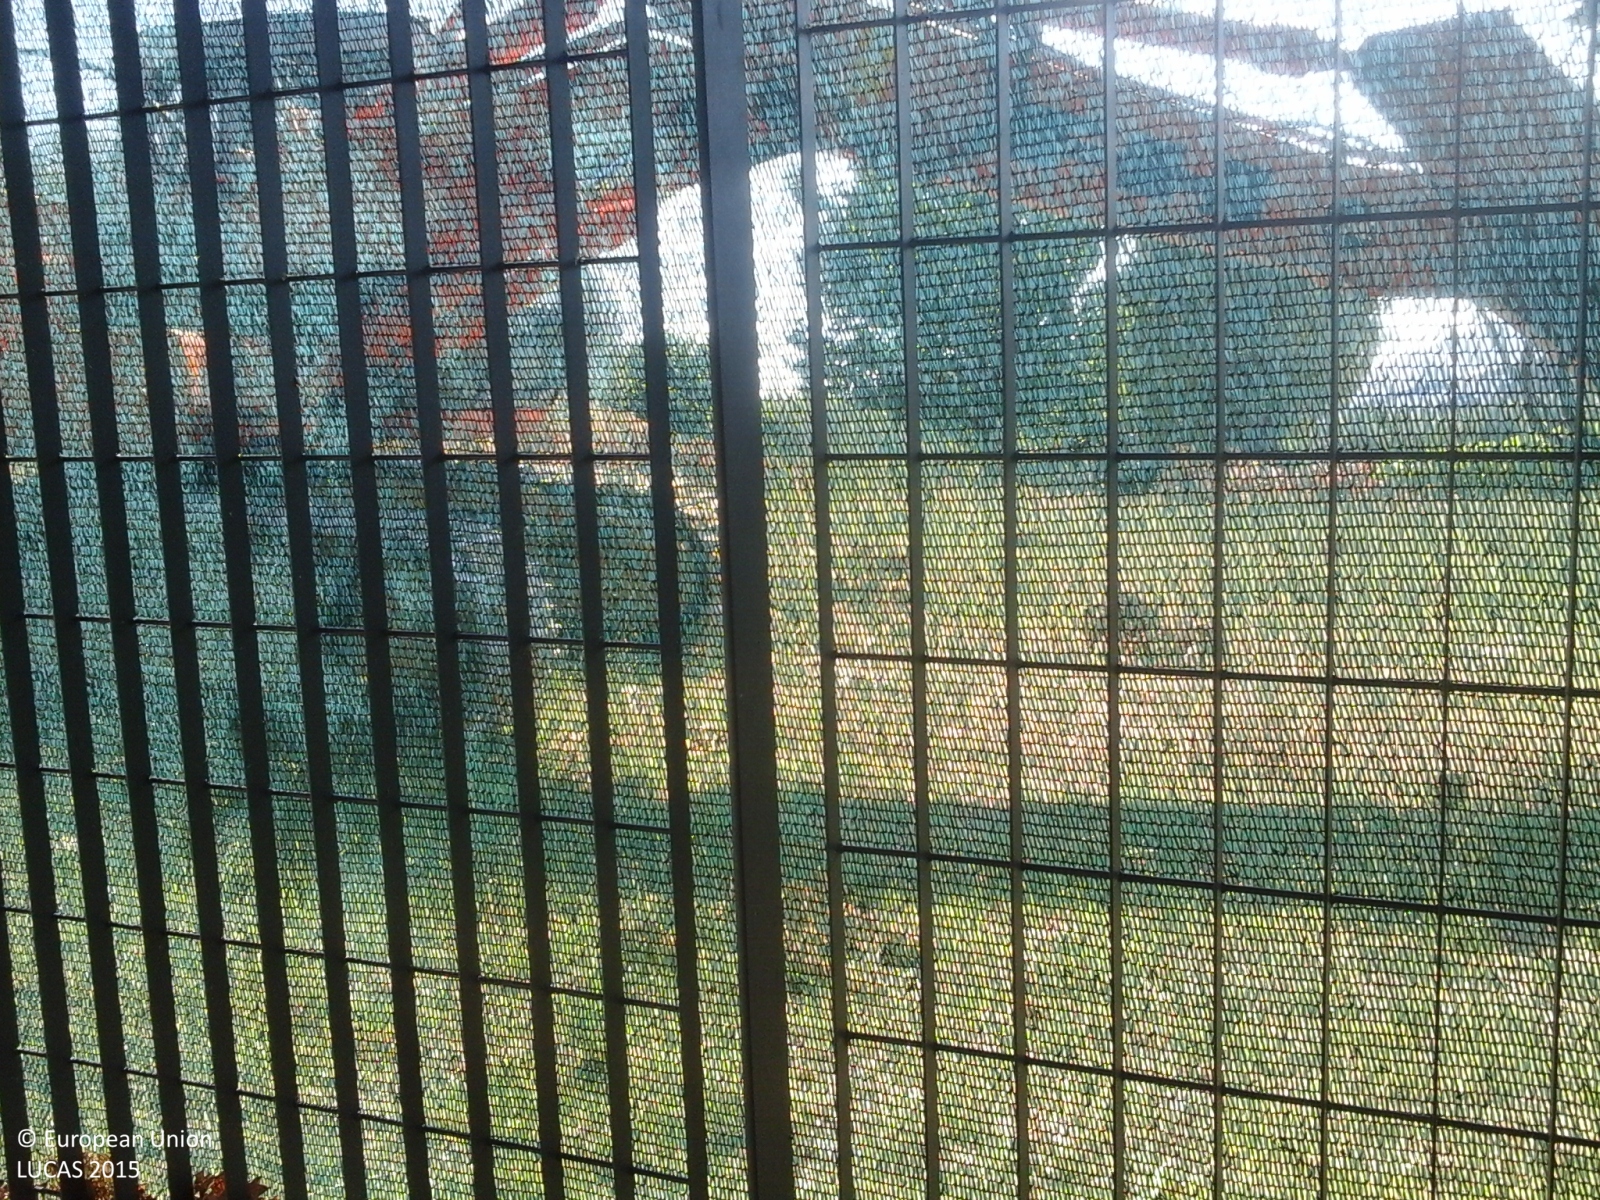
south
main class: Cropland
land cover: Olive groves
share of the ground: > 75 %
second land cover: Grassland without tree/shrub cover
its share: > 75 %
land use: Agriculture (excluding fallow land and kitchen gardens)
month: July
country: IT
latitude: 44.0148
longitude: 12.4517
